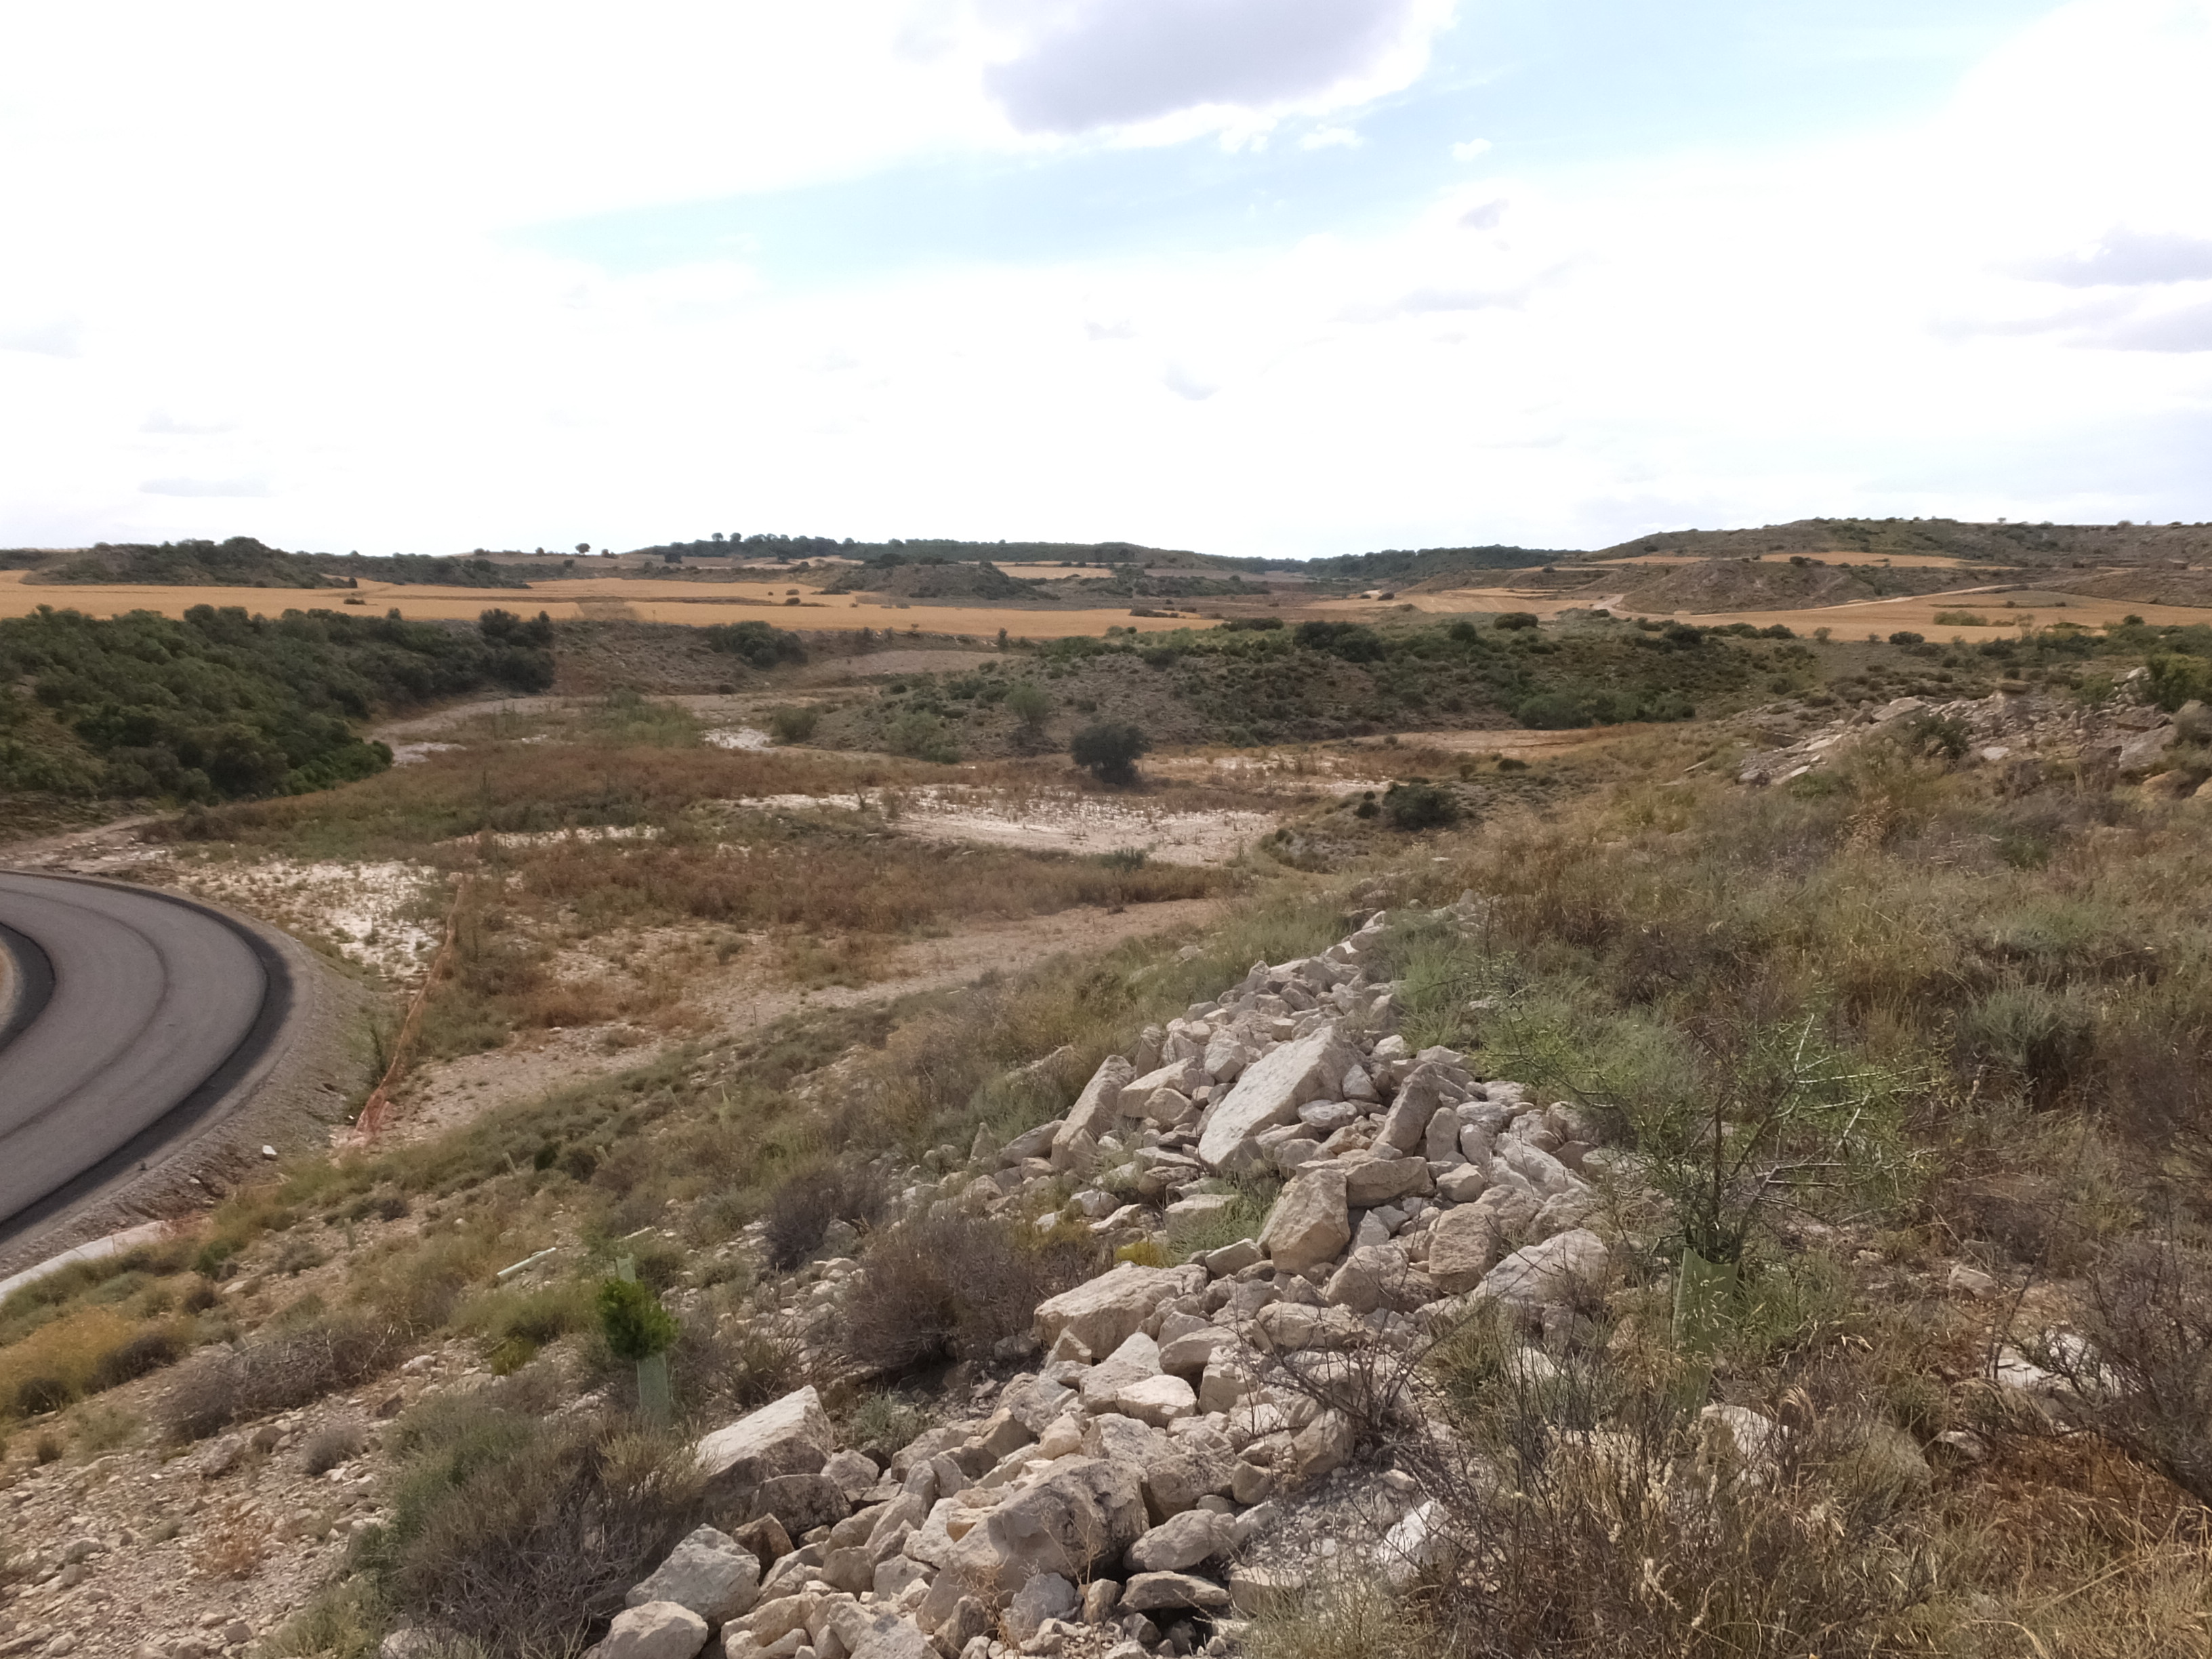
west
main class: Shrubland
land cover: Shrubland with sparse tree cover
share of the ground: 50 - 75 %
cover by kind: shrubs 60 %, herbaceous plants 35 %, coniferous forest trees 5 %
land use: Semi-natural and natural areas not in use
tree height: < 5 m
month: June
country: ES
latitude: 41.5622
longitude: 0.0447
